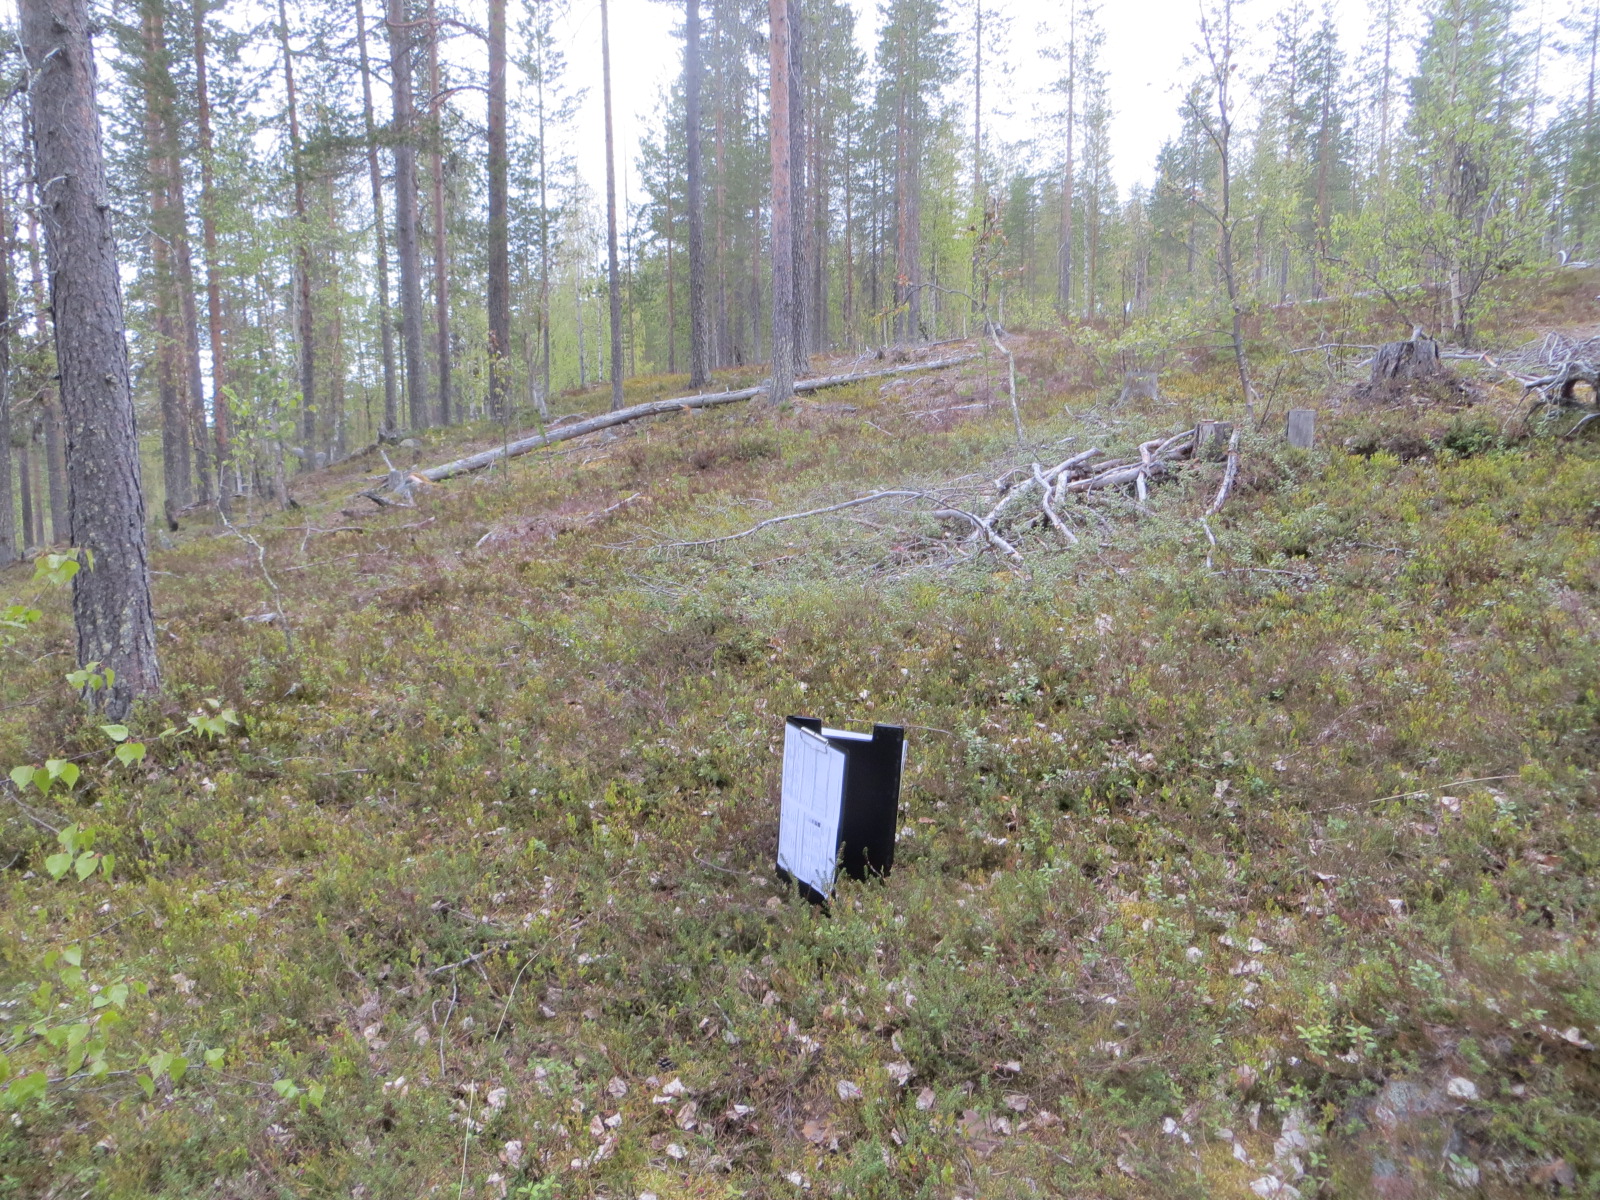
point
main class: Woodland
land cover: Pine dominated coniferous woodland
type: boreal forest
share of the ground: 50 - 75 %
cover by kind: coniferous forest trees 65 %, shrubs 15 %, broadleaved forest trees 10 %, herbaceous plants 5 %, lichens and mosses 5 %
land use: Forestry
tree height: > 5 m
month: June
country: FI
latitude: 67.5705
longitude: 25.7657
